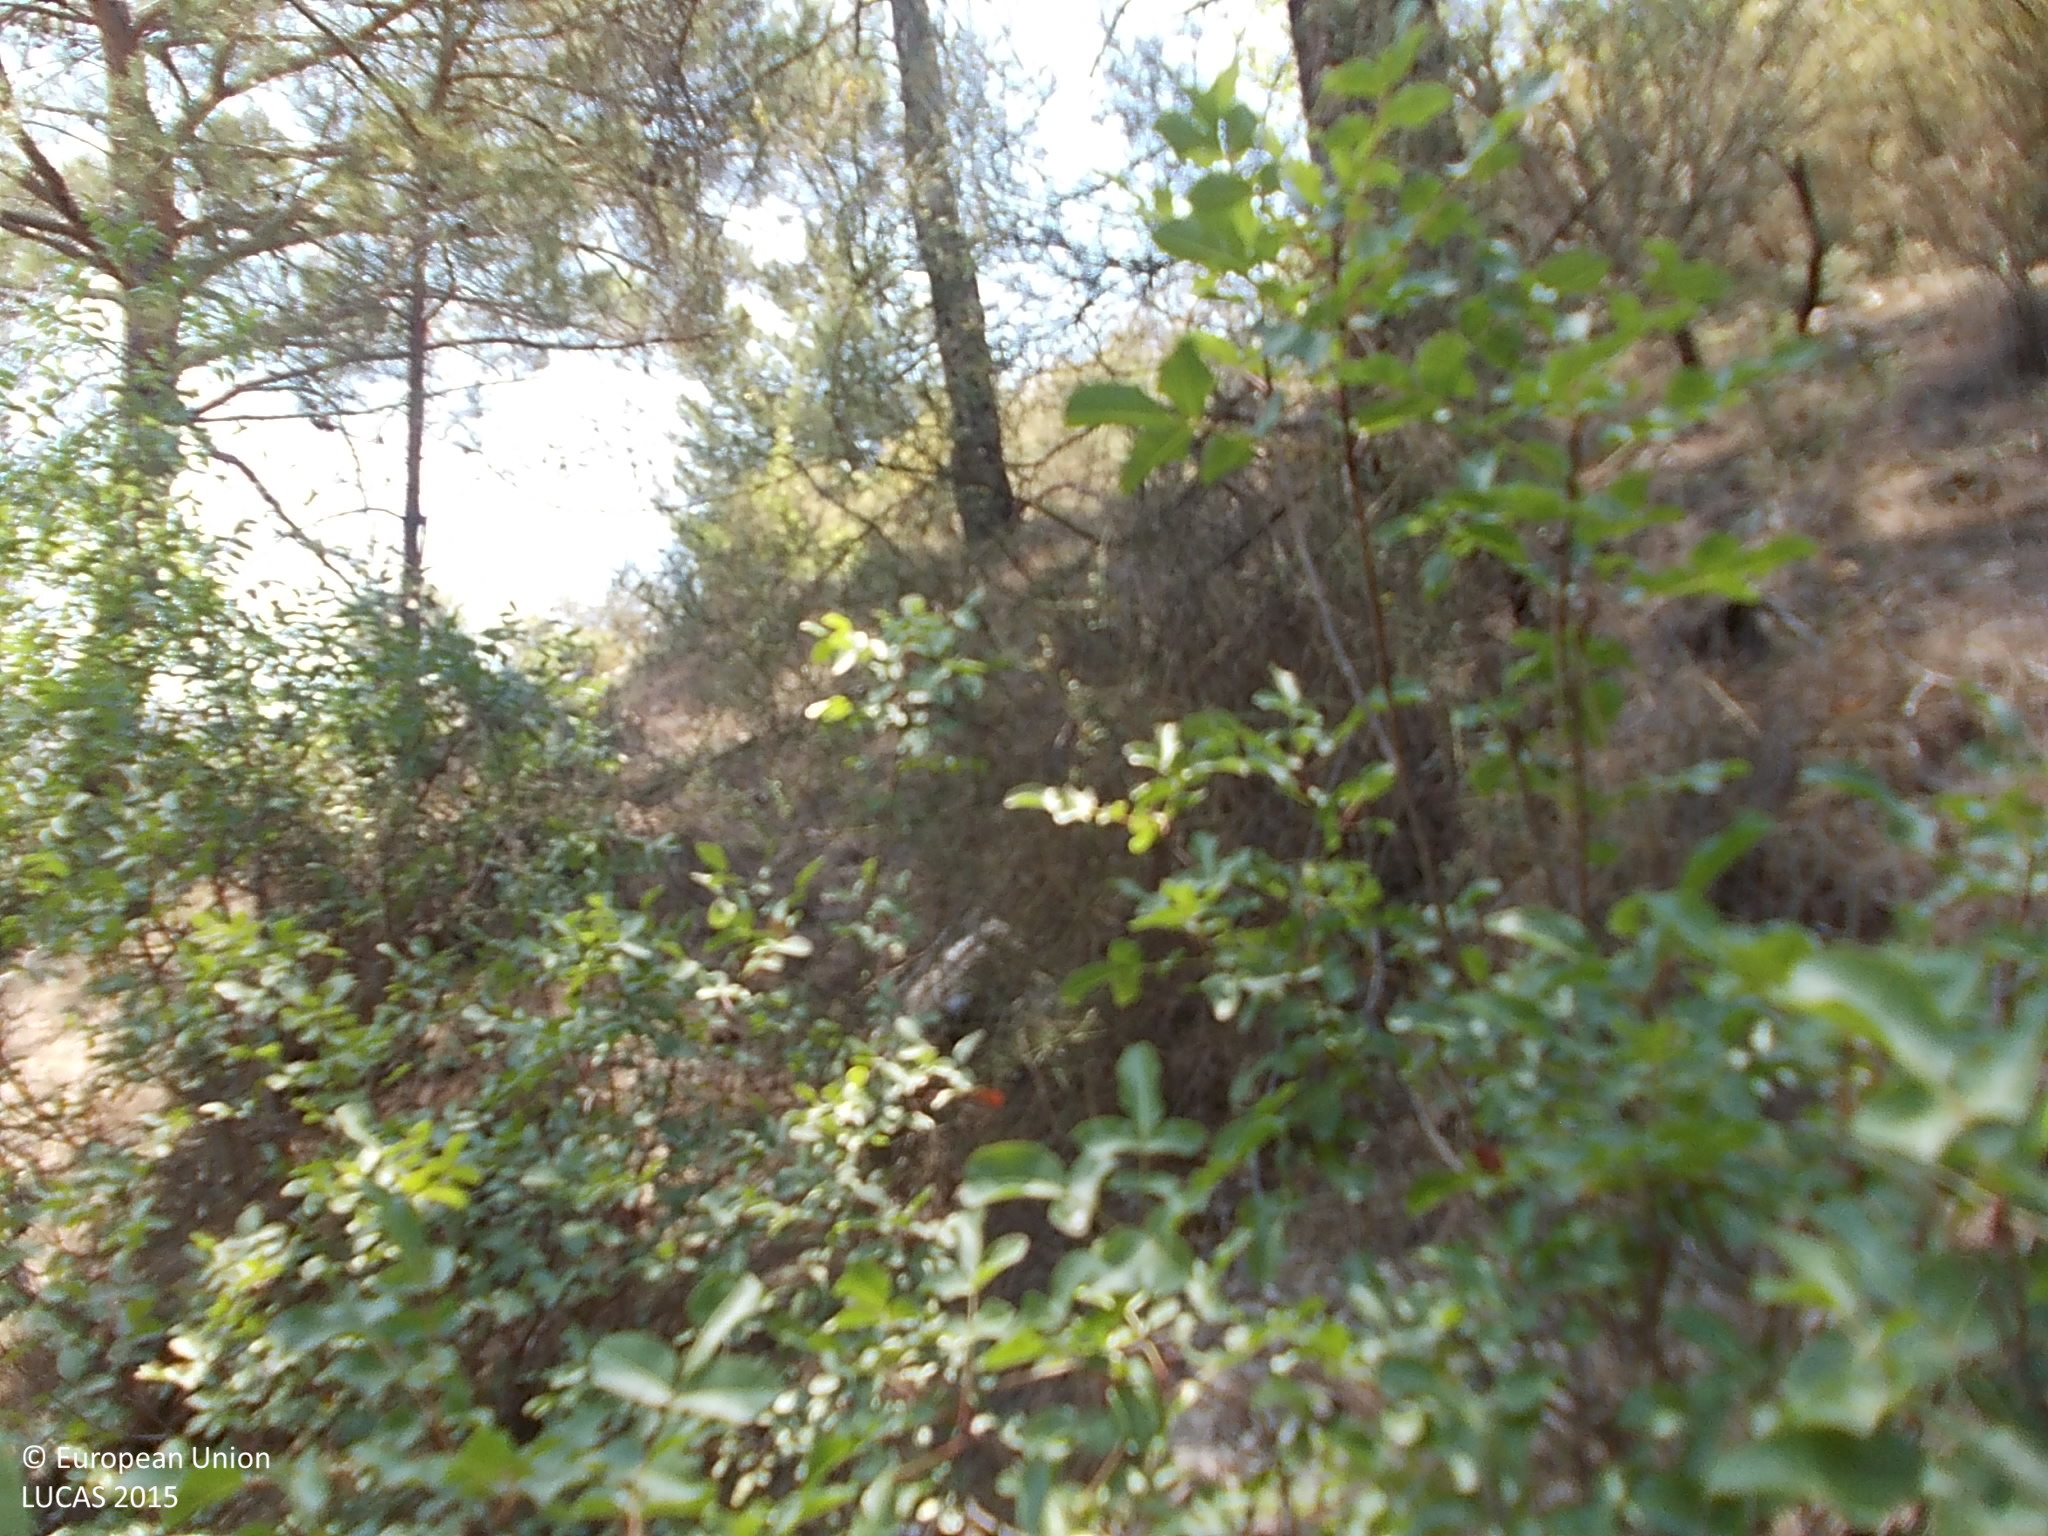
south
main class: Woodland
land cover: Pine dominated coniferous woodland
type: coniferous forest of the mediterranean region
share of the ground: > 75 %
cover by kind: coniferous forest trees 75 %, shrubs 10 %, unconsolidated bare surface 10 %, broadleaved forest trees 5 %
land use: Semi-natural and natural areas not in use
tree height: > 5 m
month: July
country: CY
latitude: 34.7544
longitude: 32.7132
